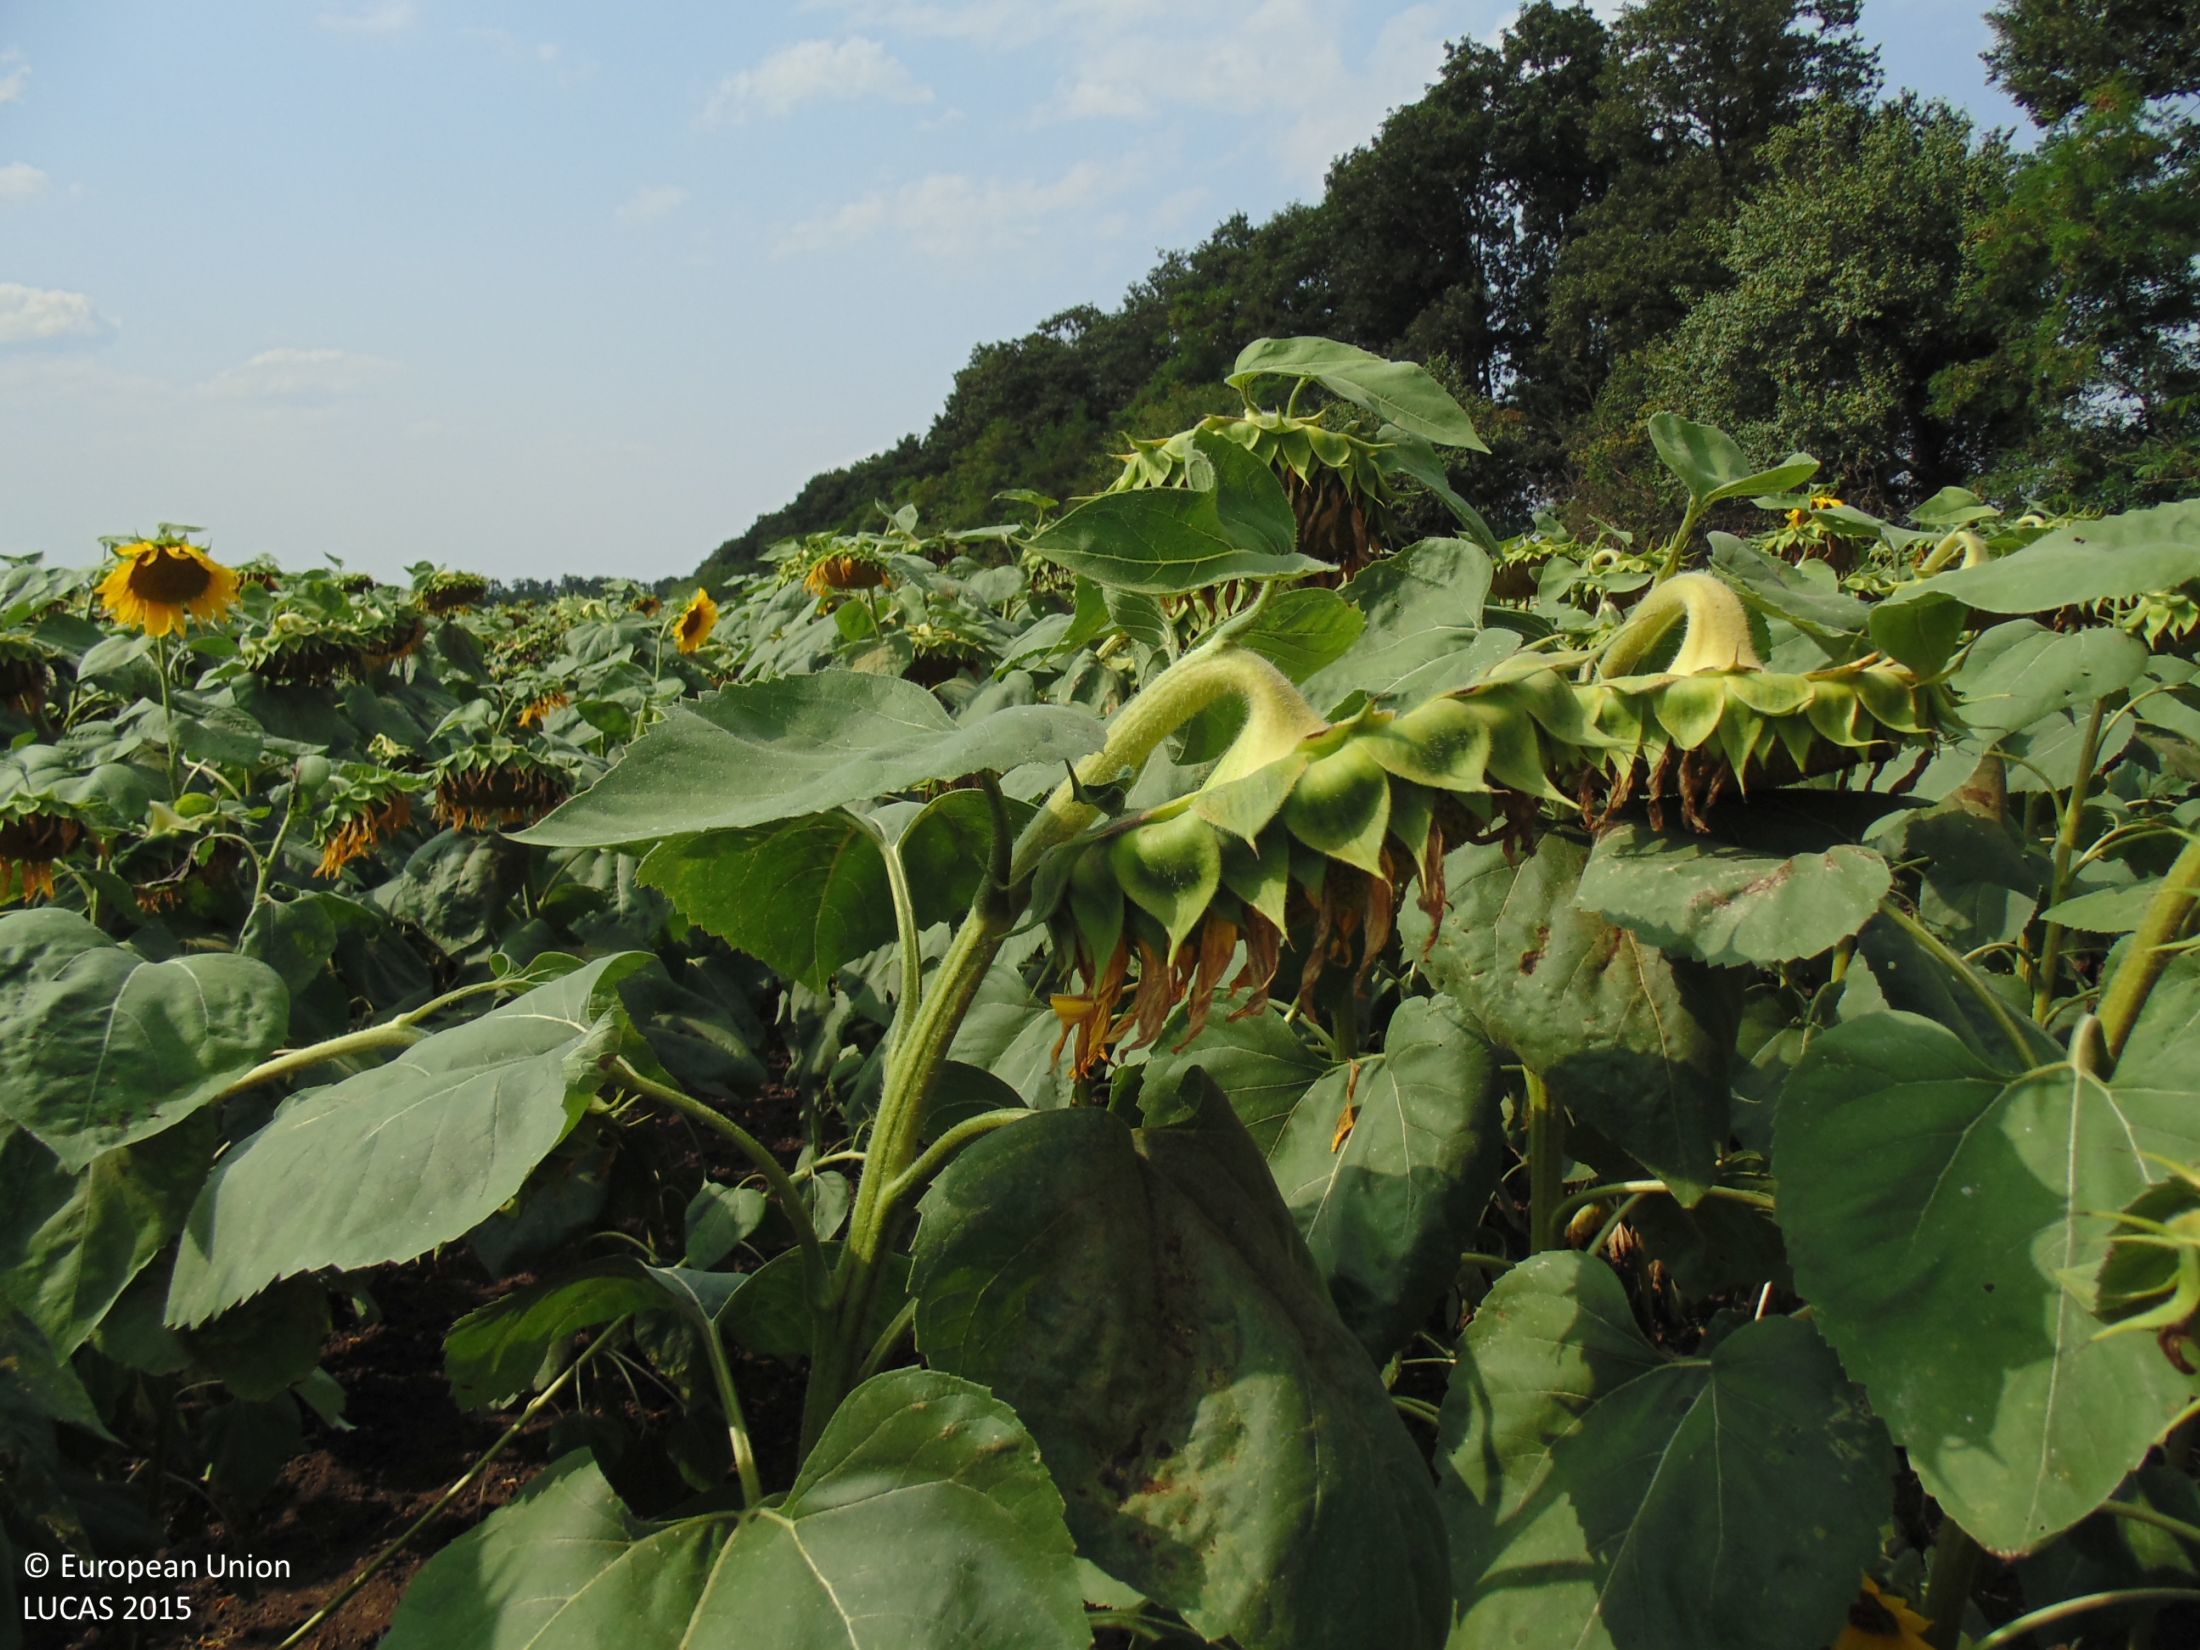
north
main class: Cropland
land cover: Sunflower
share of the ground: > 75 %
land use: Agriculture (excluding fallow land and kitchen gardens)
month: July
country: BG
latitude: 43.6046
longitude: 28.0248
